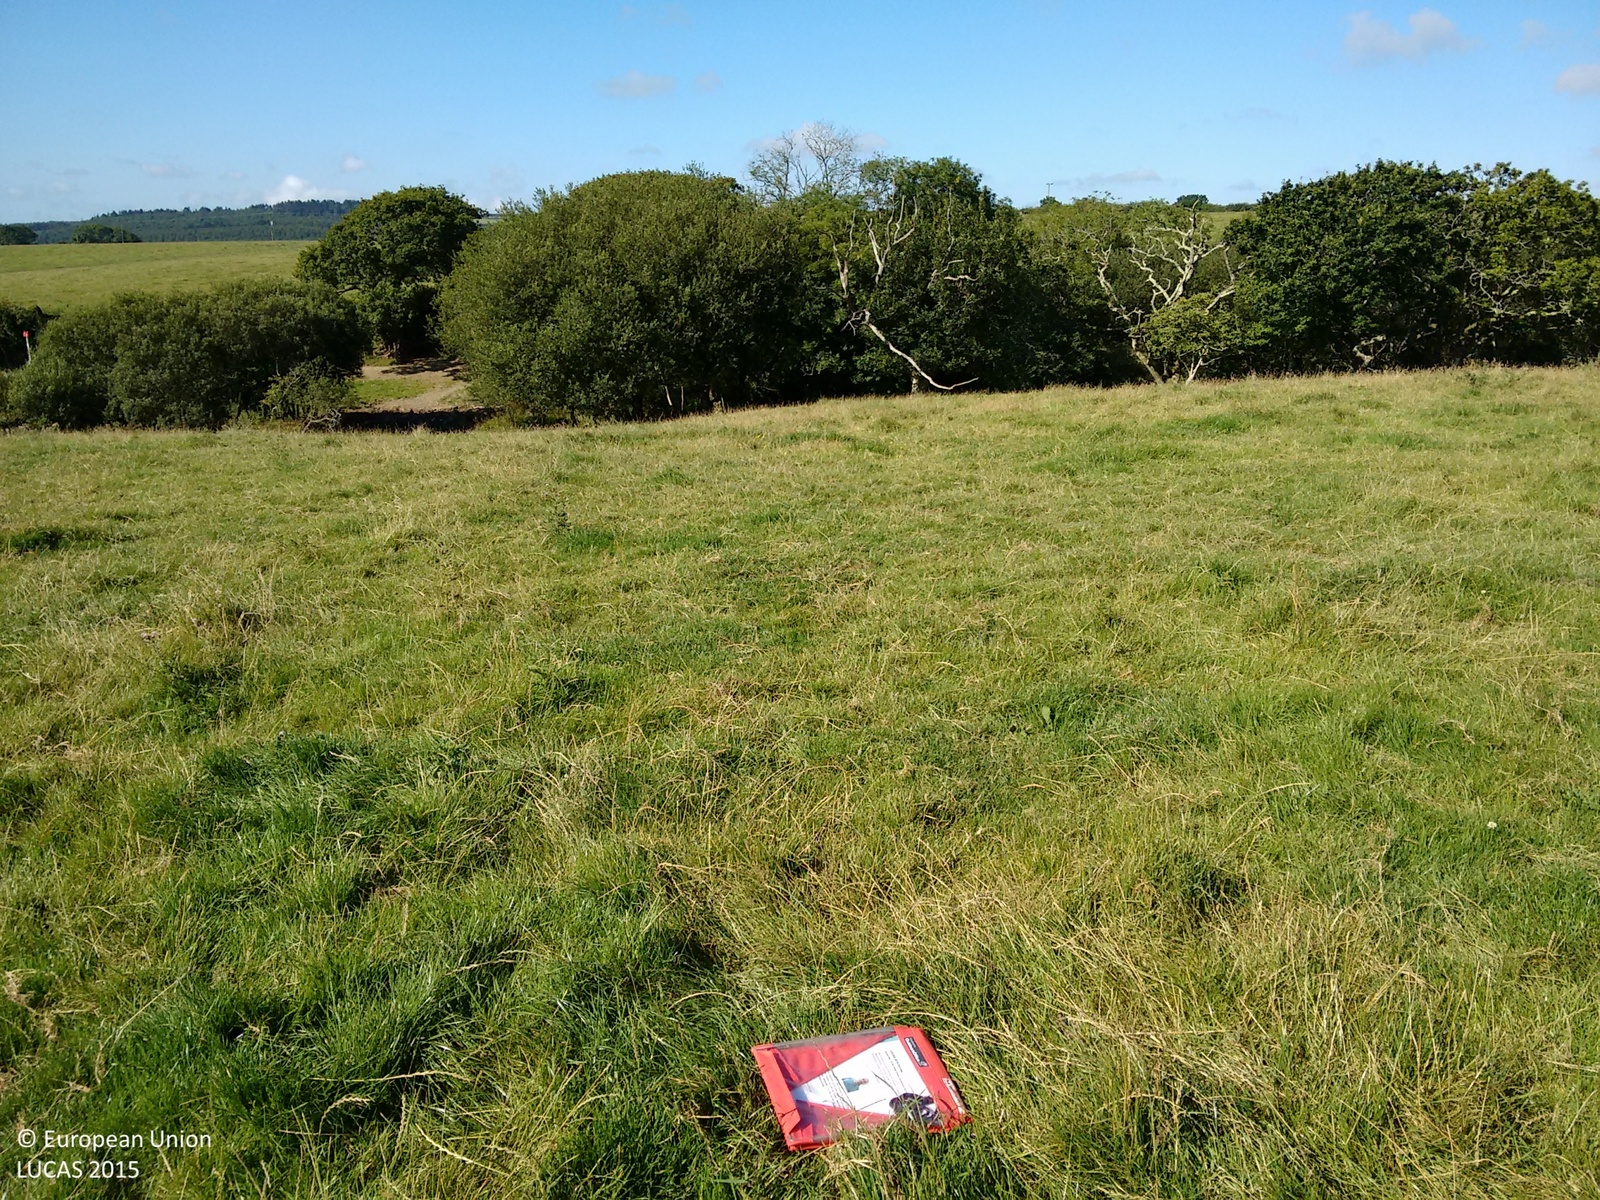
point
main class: Grassland
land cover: Grassland without tree/shrub cover
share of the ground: > 75 %
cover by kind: herbaceous plants 100 %
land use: Agriculture (excluding fallow land and kitchen gardens)
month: August
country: GB
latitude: 51.7443
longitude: -4.8725
